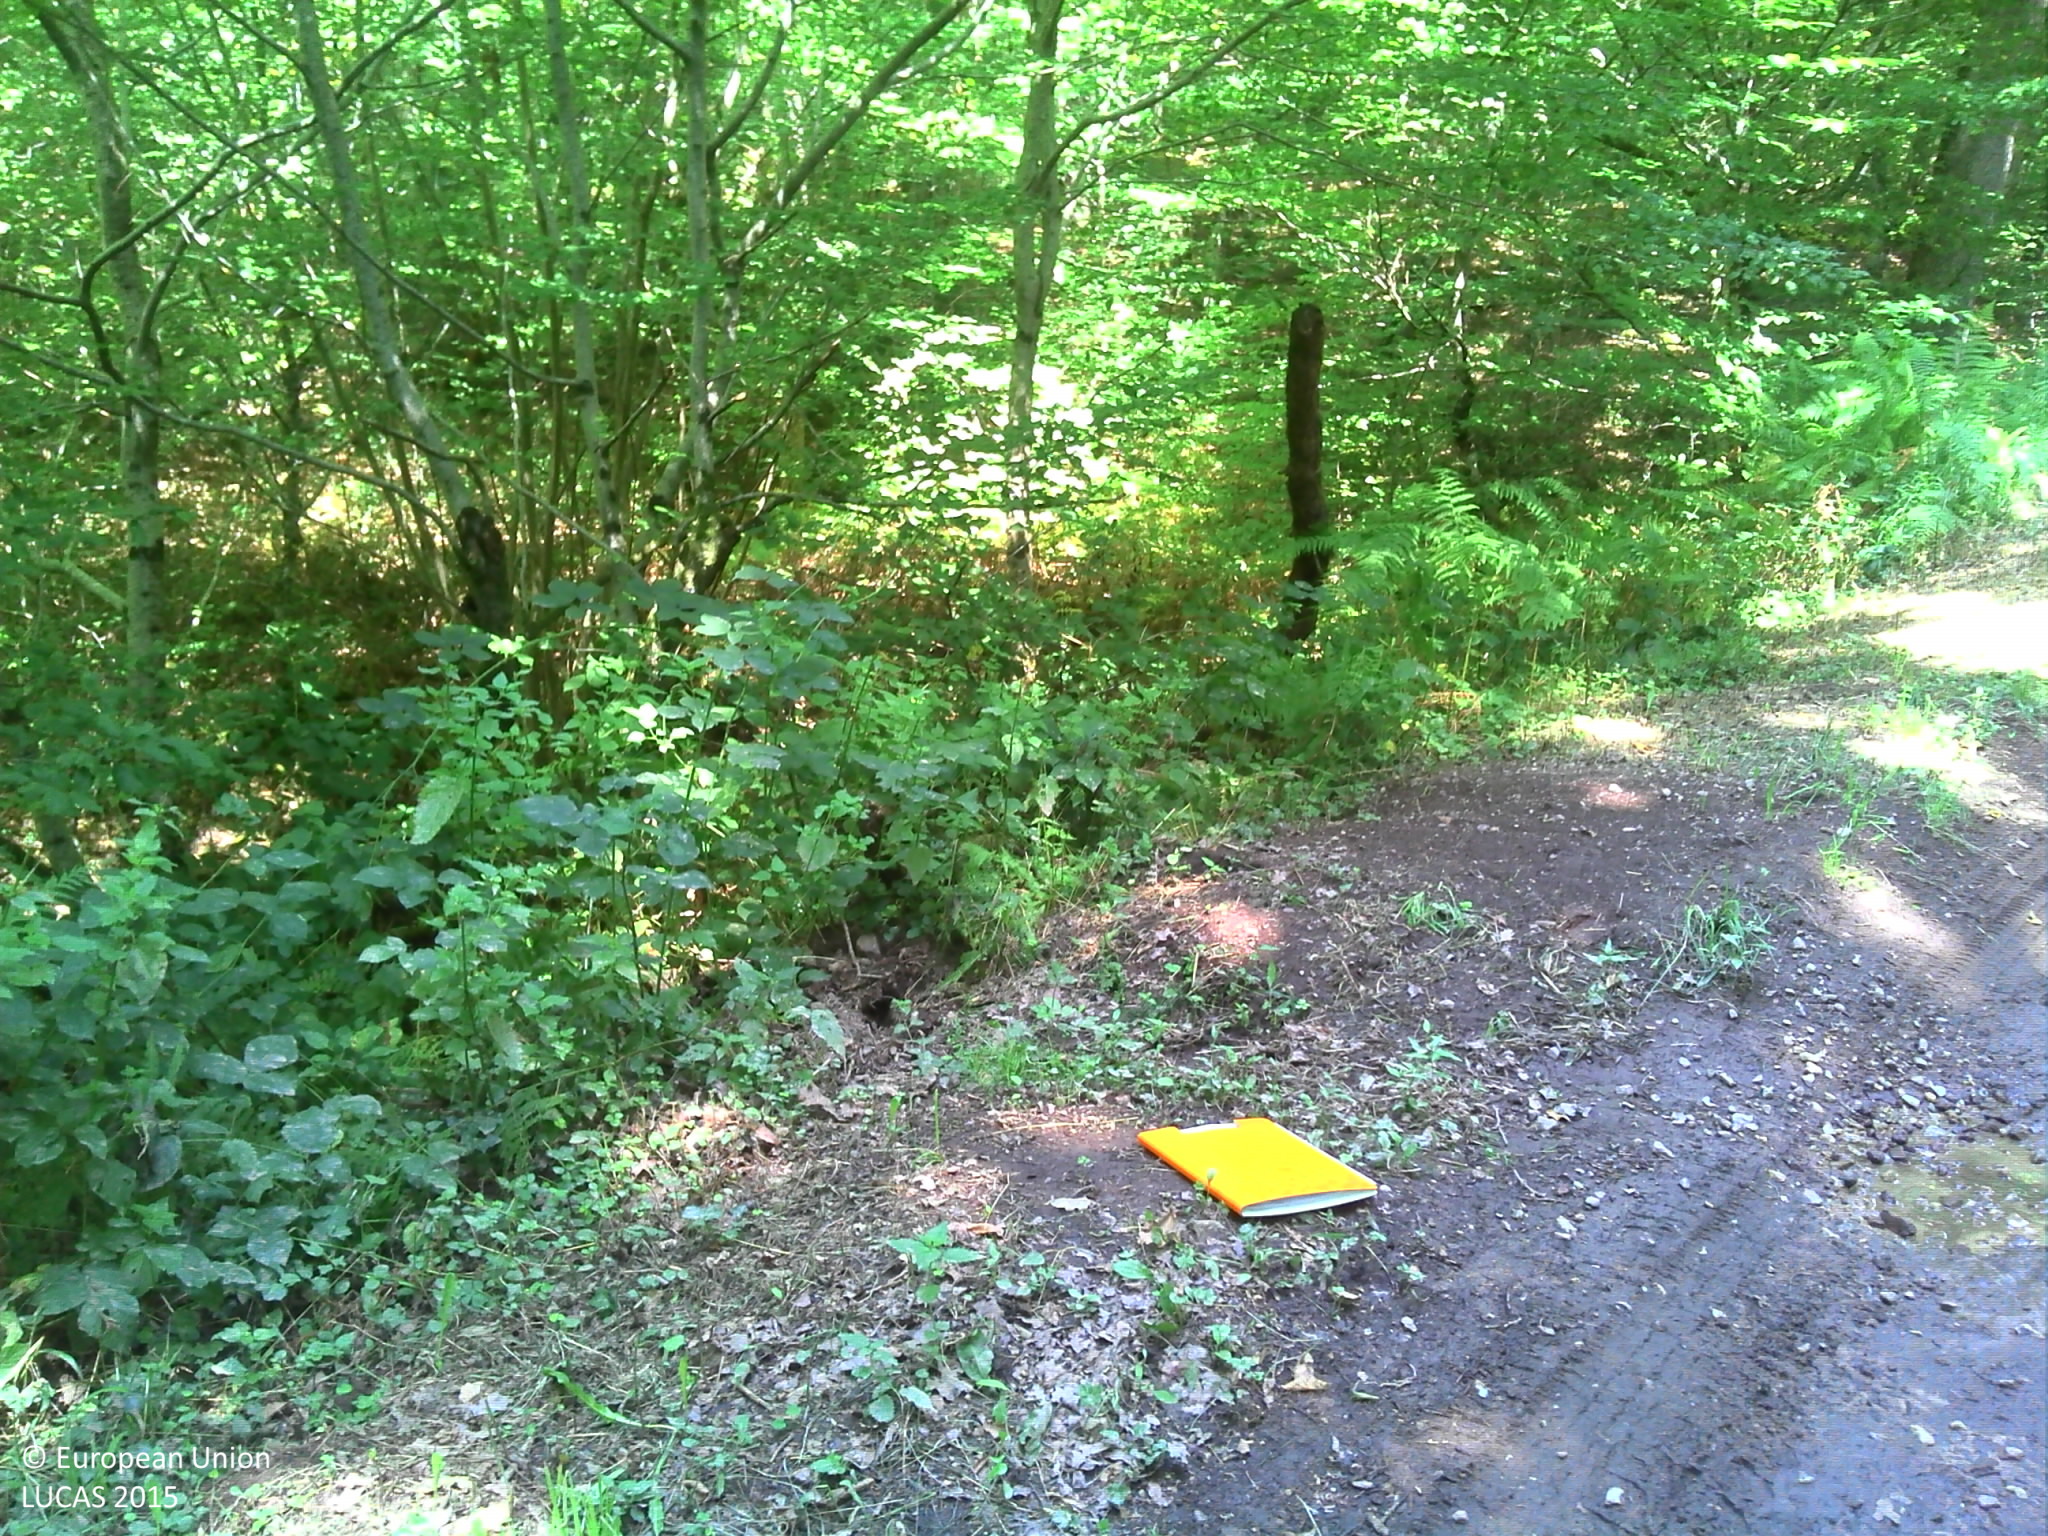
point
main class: Woodland
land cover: Broadleaved woodland
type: mesophytic deciduous forest
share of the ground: > 75 %
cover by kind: broadleaved forest trees 90 %, herbaceous plants 10 %
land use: Forestry
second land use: Amenities, museums, leisure
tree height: > 5 m
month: August
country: FR
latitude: 46.6667
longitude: 2.7679
